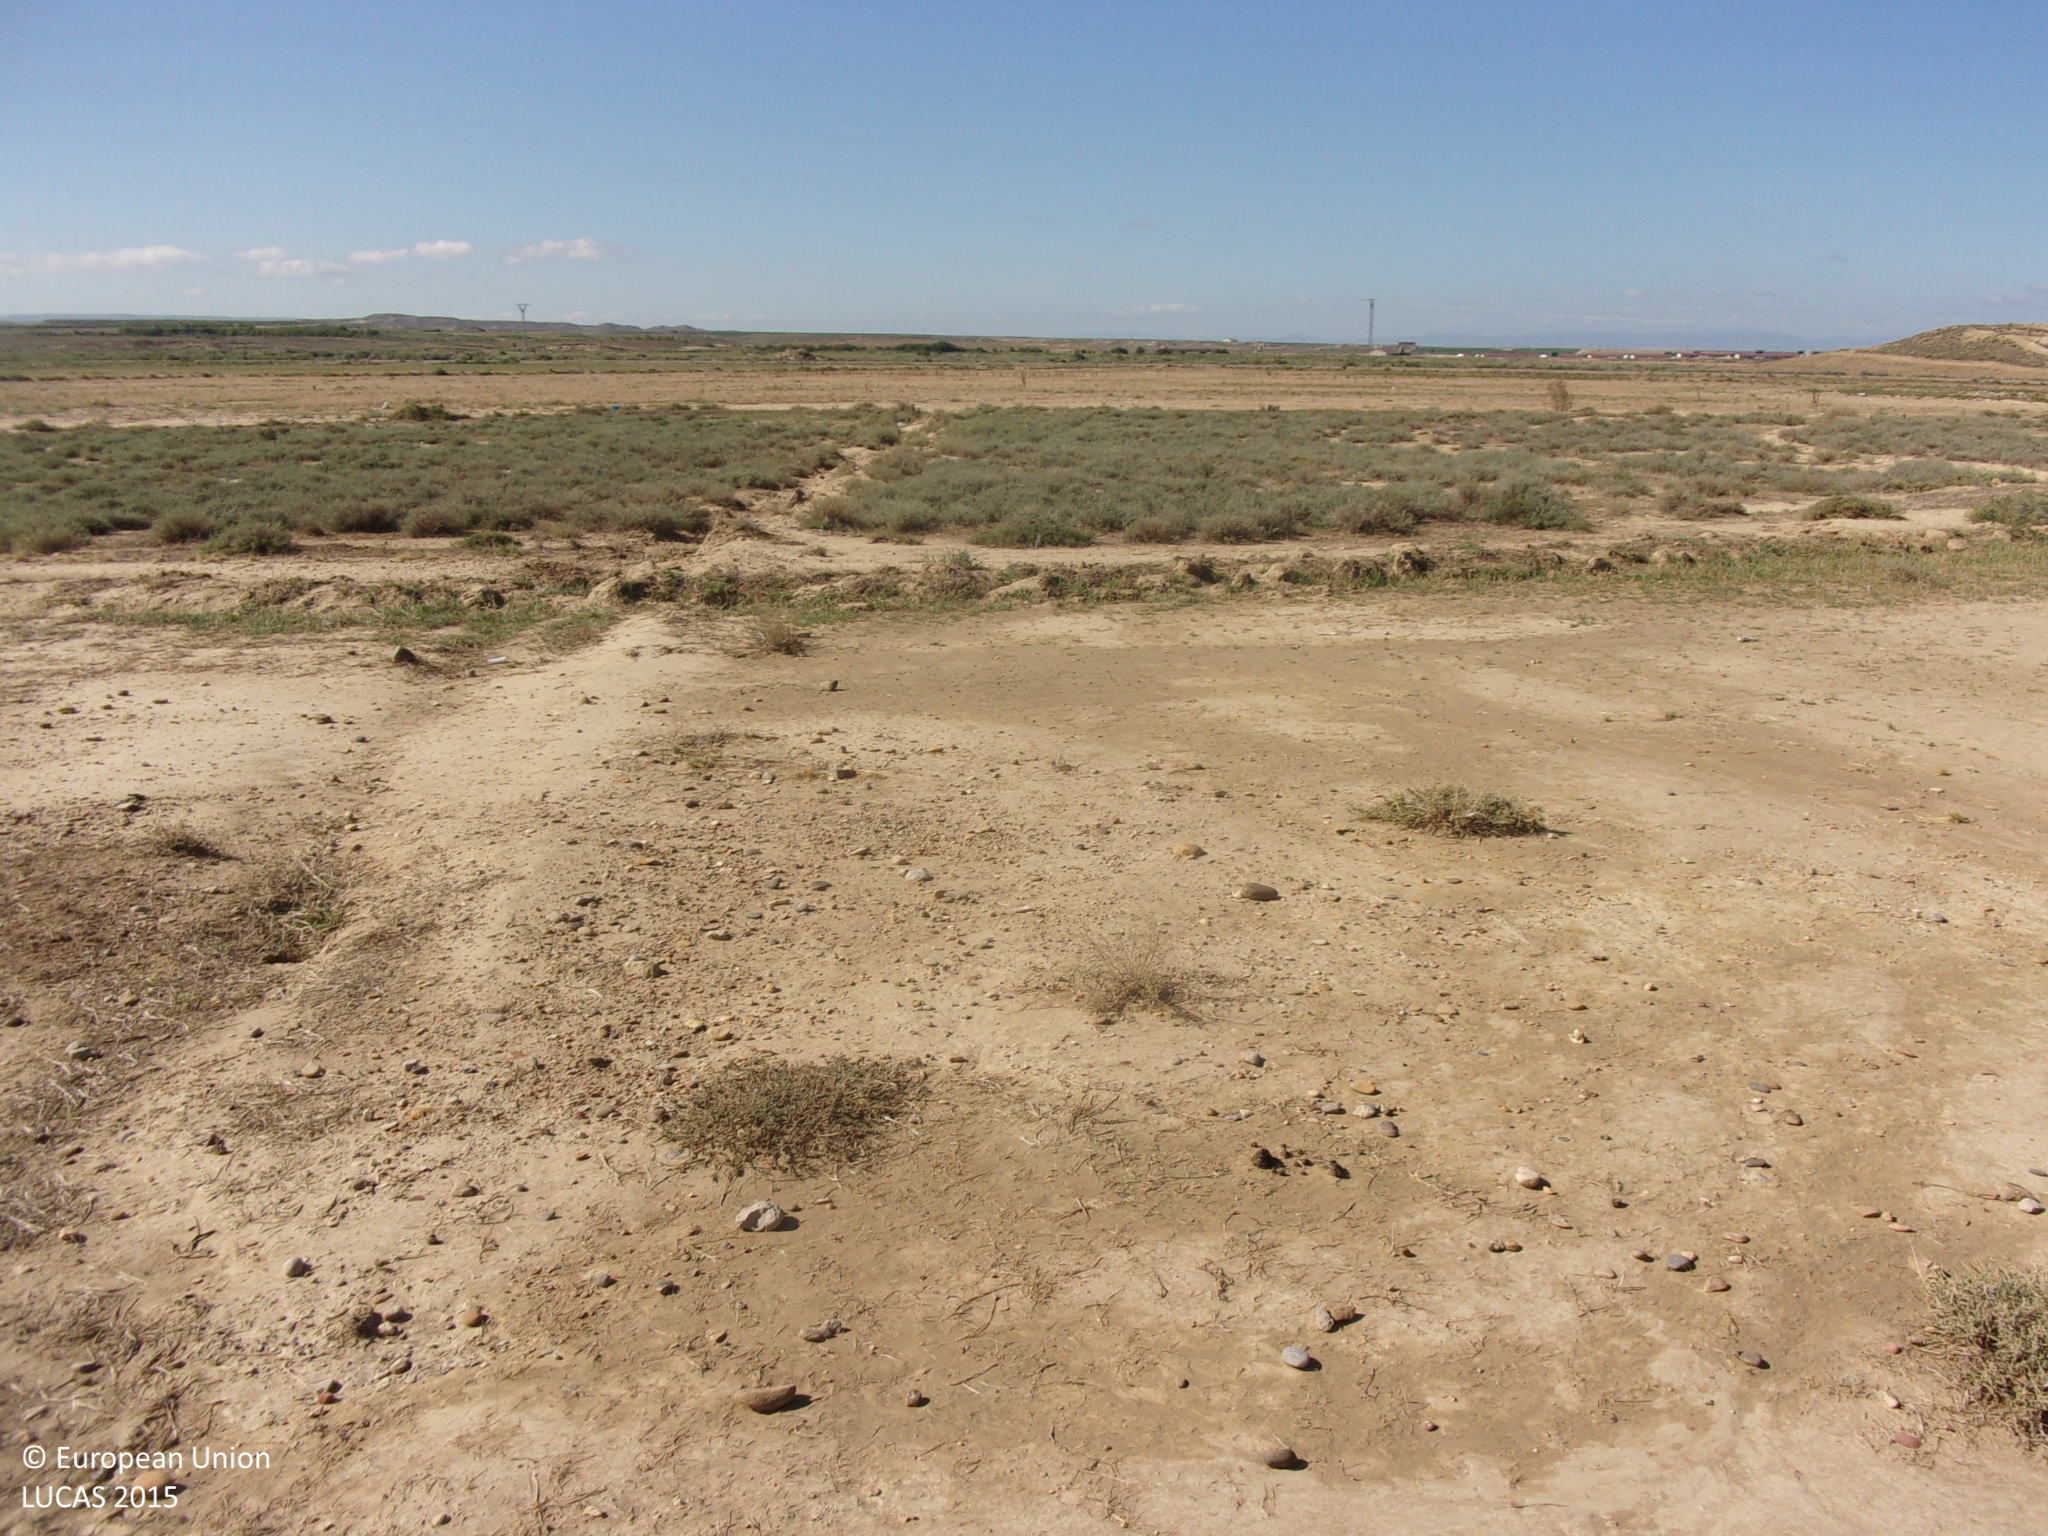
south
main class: Shrubland
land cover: Shrubland without tree cover
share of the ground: 10 - 25 %
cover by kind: consolidated bare surface 90 %, shrubs 10 %
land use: Abandoned areas
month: August
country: ES
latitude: 42.0923
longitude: -1.1388
